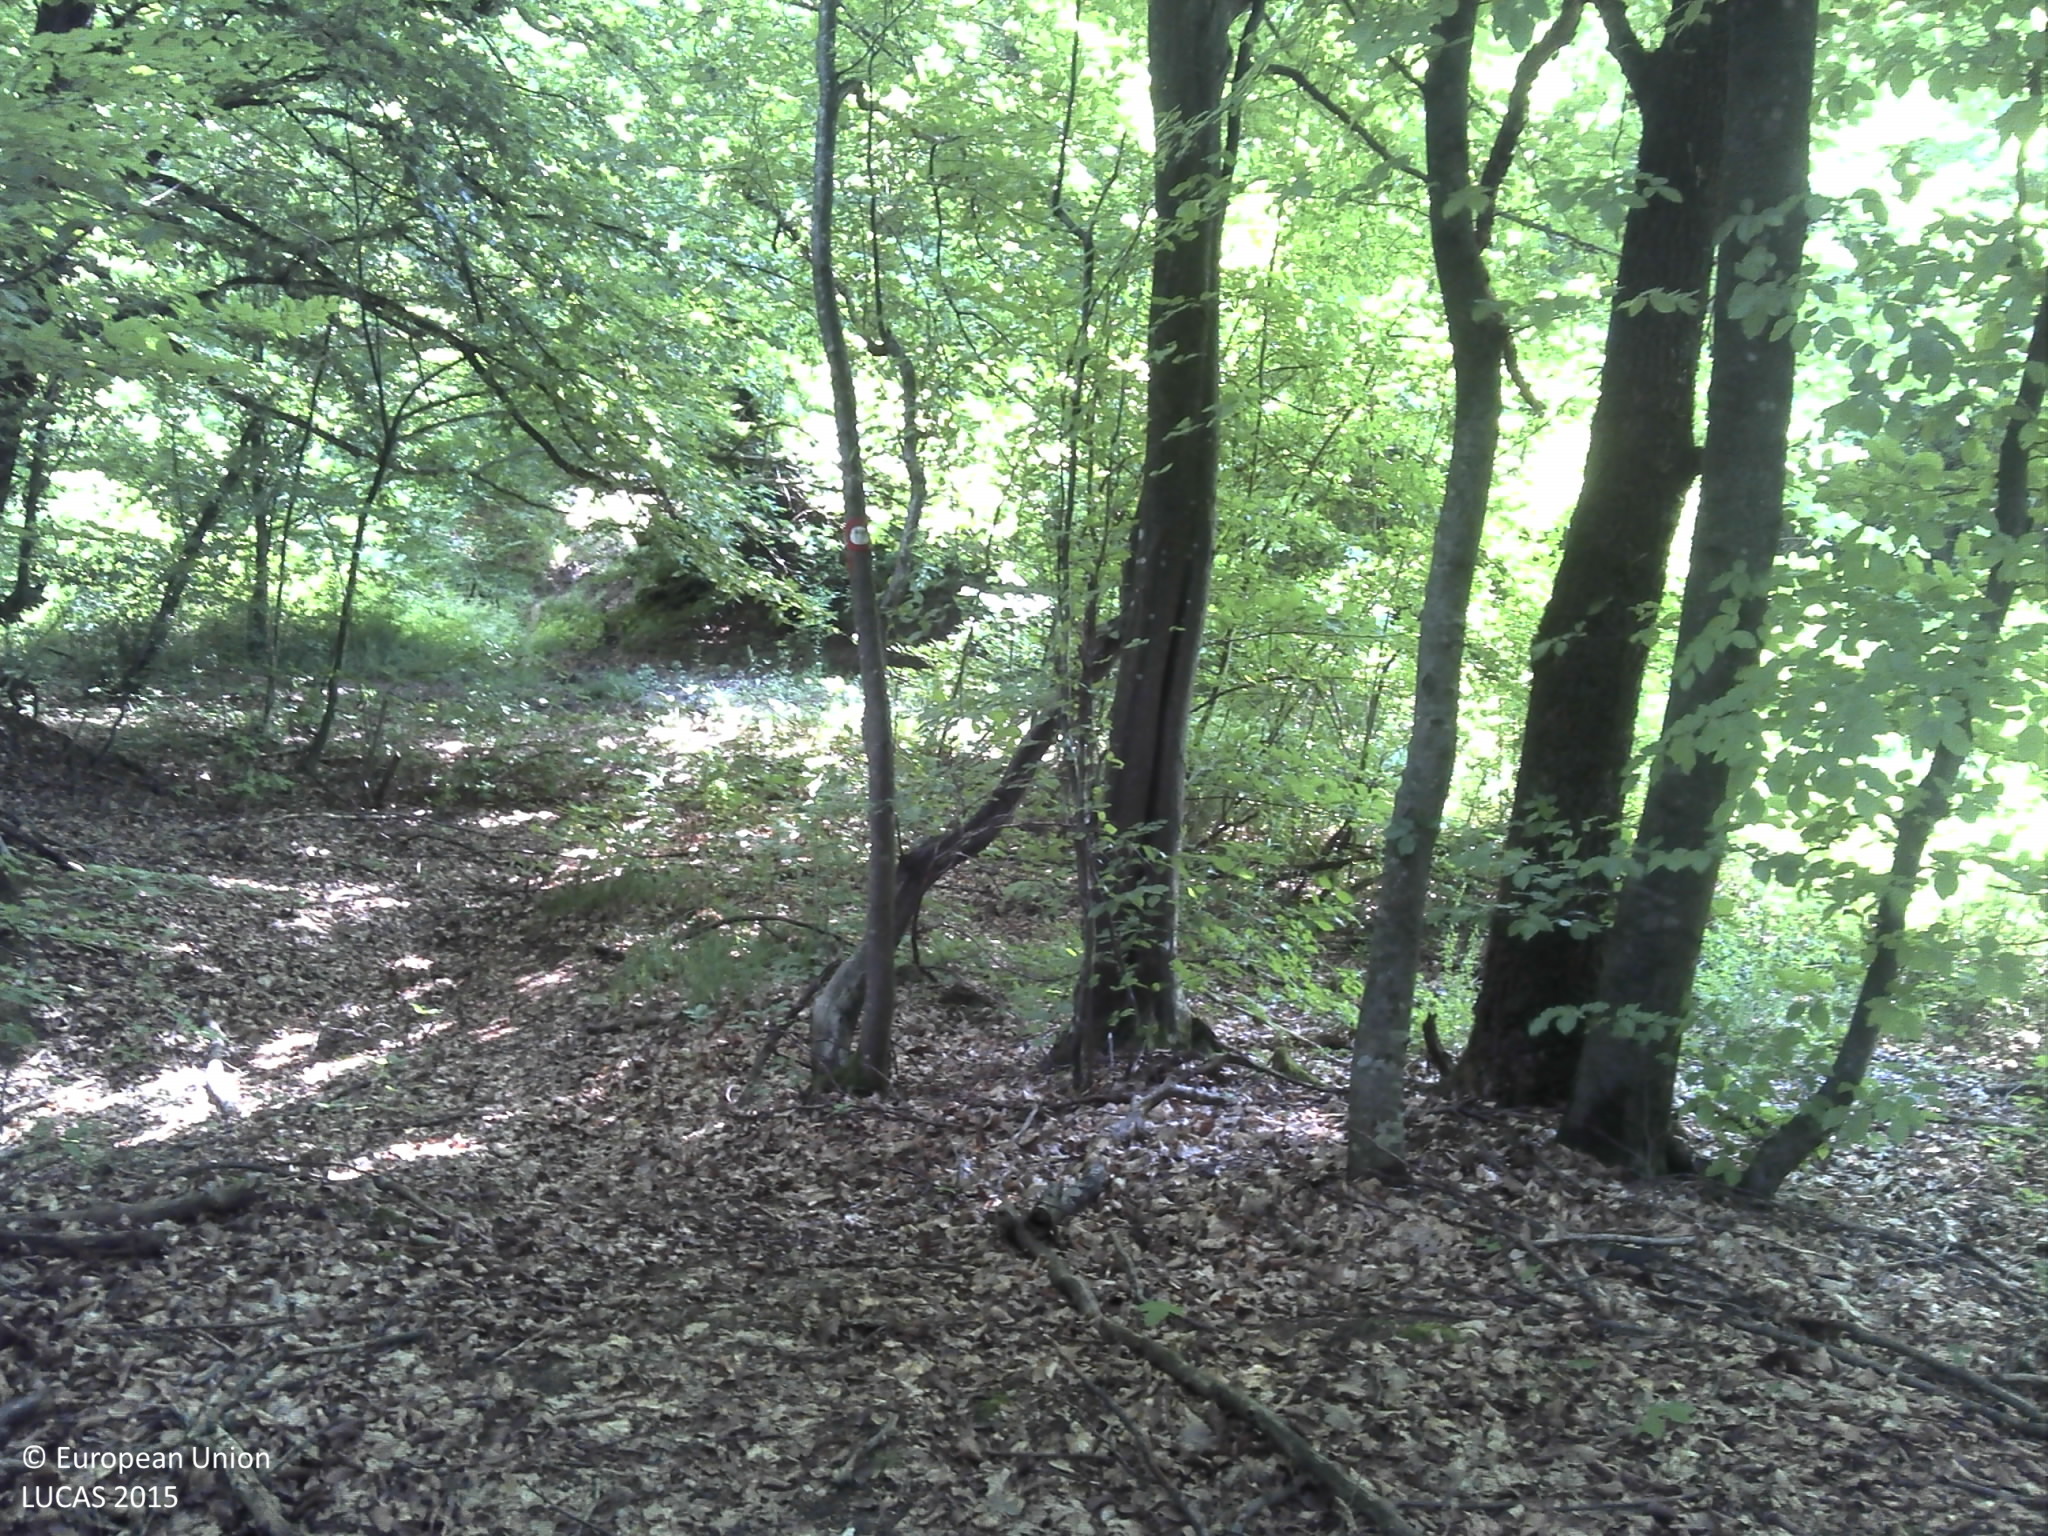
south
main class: Woodland
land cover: Broadleaved woodland
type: beech forest
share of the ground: > 75 %
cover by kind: broadleaved forest trees 80 %, lichens and mosses 20 %
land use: Forestry
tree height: > 5 m
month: June
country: HR
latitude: 45.3839
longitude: 17.2159
